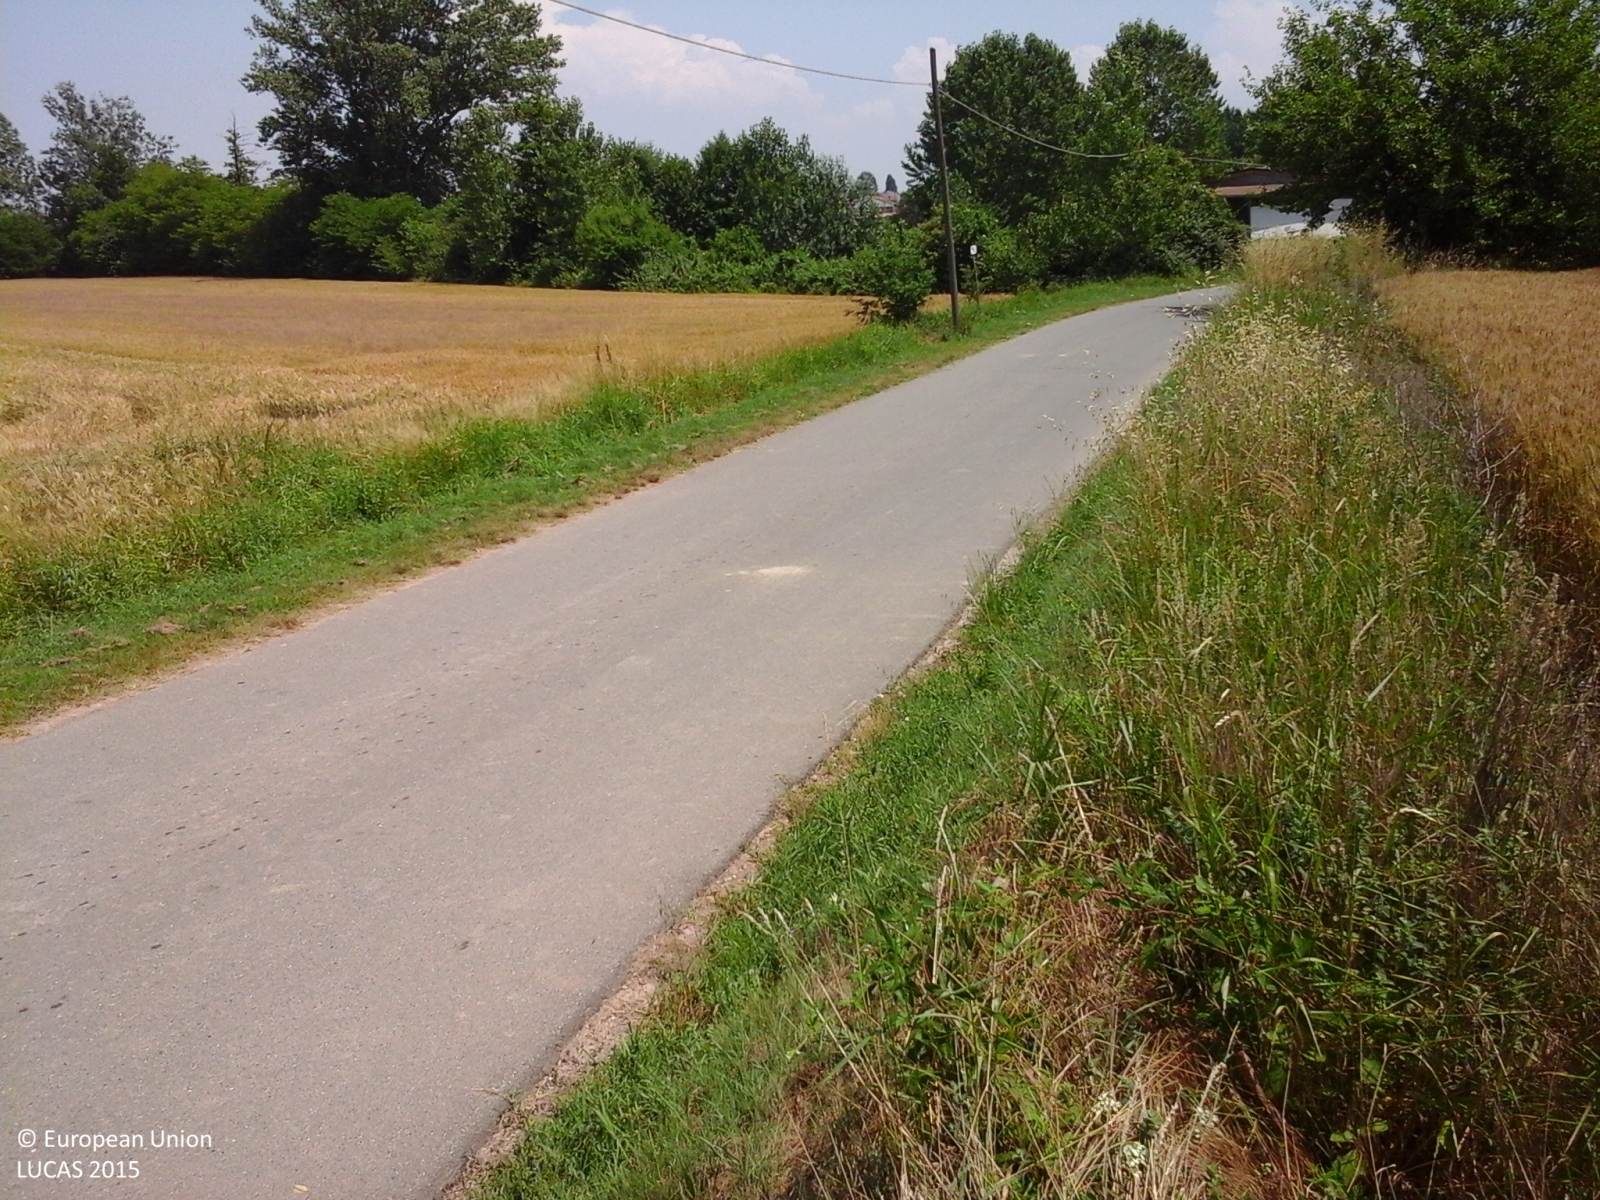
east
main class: Cropland
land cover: Common wheat
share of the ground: > 75 %
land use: Agriculture (excluding fallow land and kitchen gardens)
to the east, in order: Common wheat; Grass margins; Paved roads, cycling and walking lanes; Electric lines; Grass margins; Common wheat; Broadleaved woodland; Ditches and canals; Broadleaved woodland; Maize
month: June
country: IT
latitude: 44.8270
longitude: 8.5231
